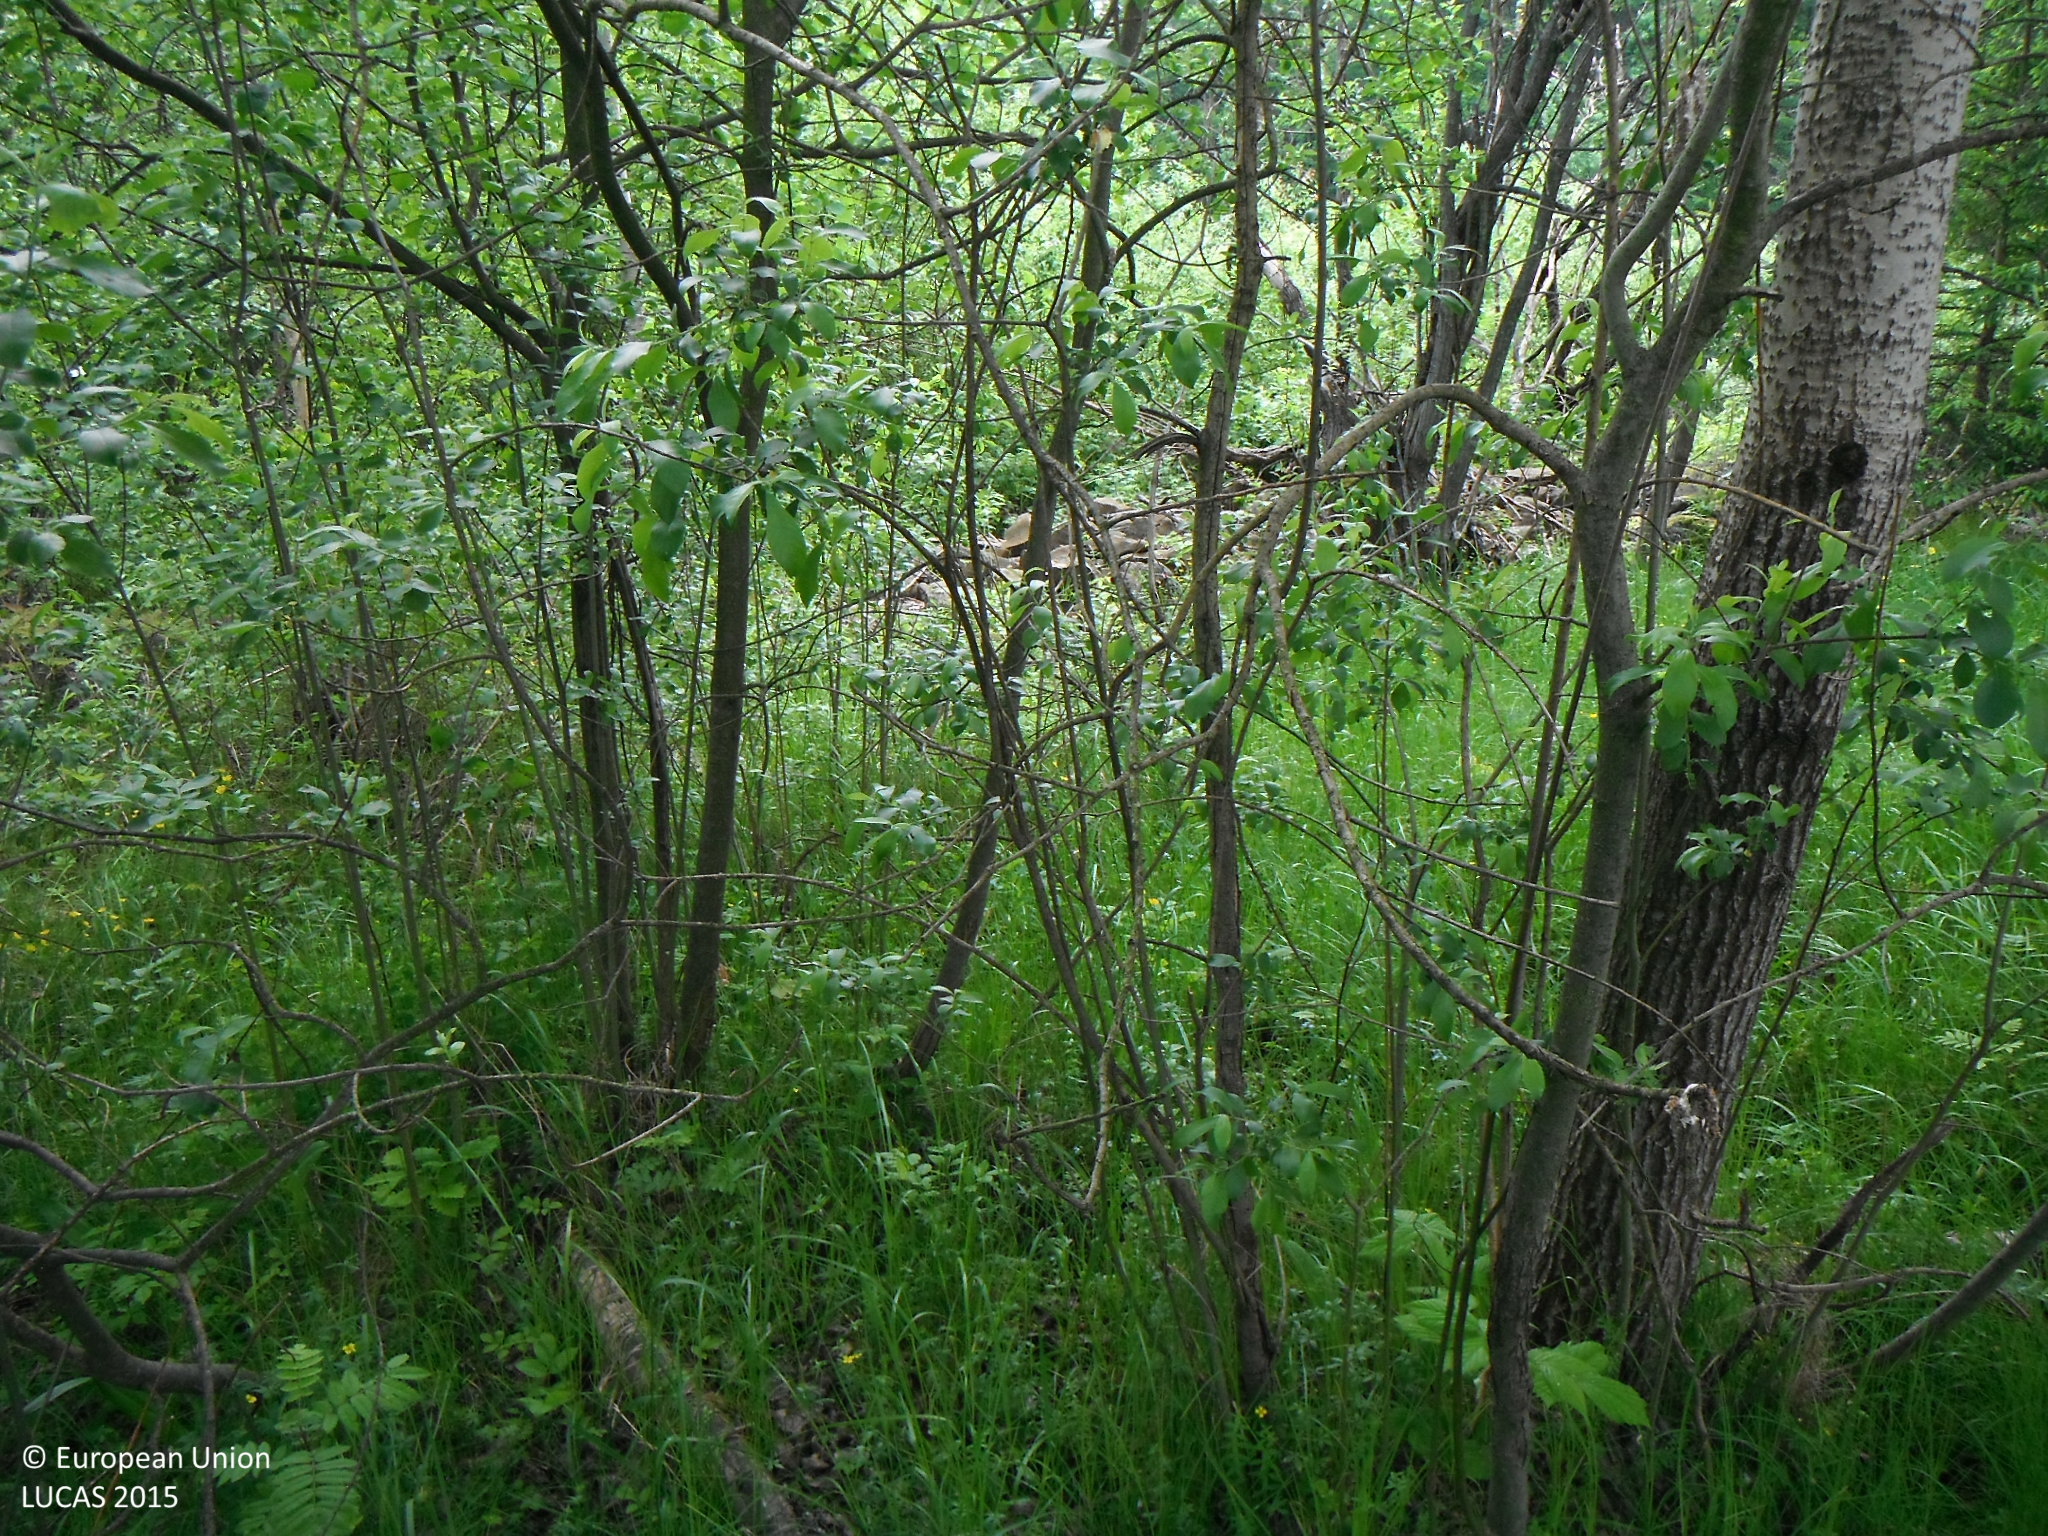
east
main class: Woodland
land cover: Broadleaved woodland
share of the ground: > 75 %
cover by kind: broadleaved forest trees 85 %, herbaceous plants 10 %, shrubs 5 %
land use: Forestry
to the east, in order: Broadleaved woodland; Tracks; Broadleaved woodland
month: June
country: SK
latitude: 48.4912
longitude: 19.4012
